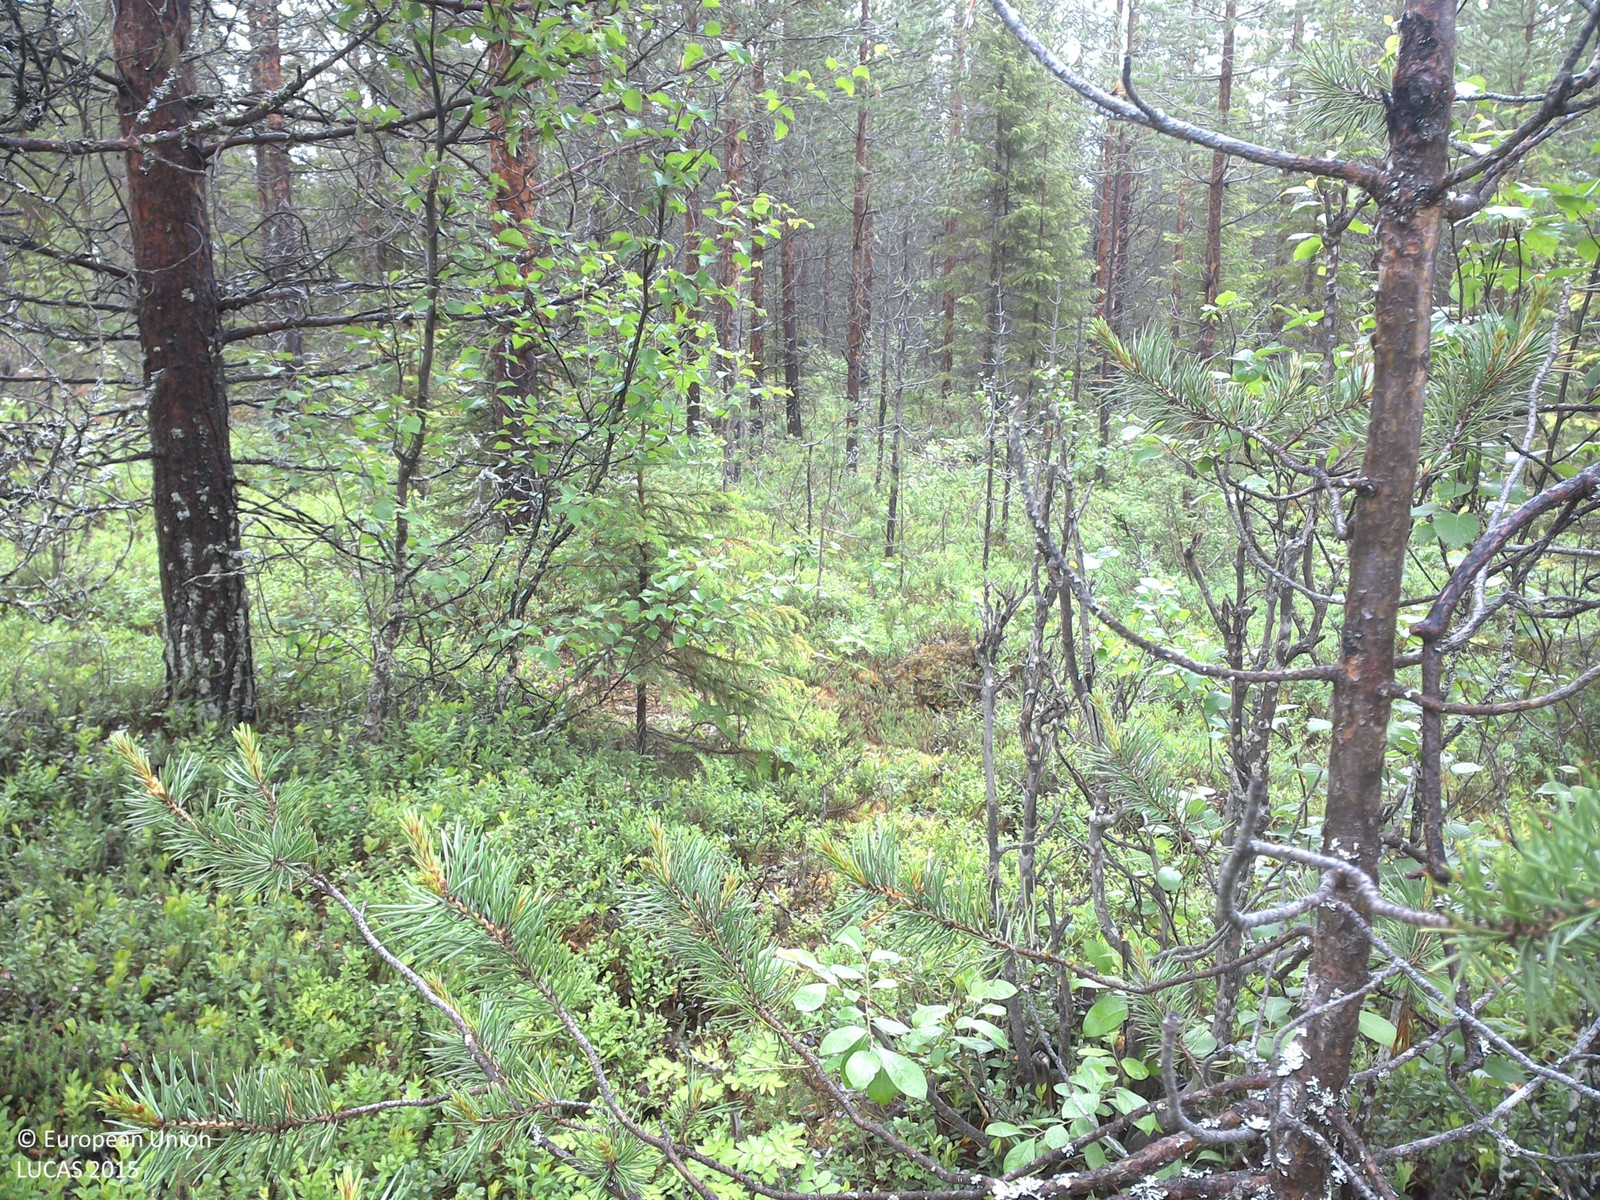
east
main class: Woodland
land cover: Pine dominated mixed woodland
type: boreal forest
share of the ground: 25 - 50 %
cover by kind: shrubs 65 %, coniferous forest trees 25 %, broadleaved forest trees 10 %
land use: Forestry
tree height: > 5 m
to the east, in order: Pine dominated mixed woodland; Tracks; Pine dominated mixed woodland
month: July
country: SE
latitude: 67.0887
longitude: 23.5804
